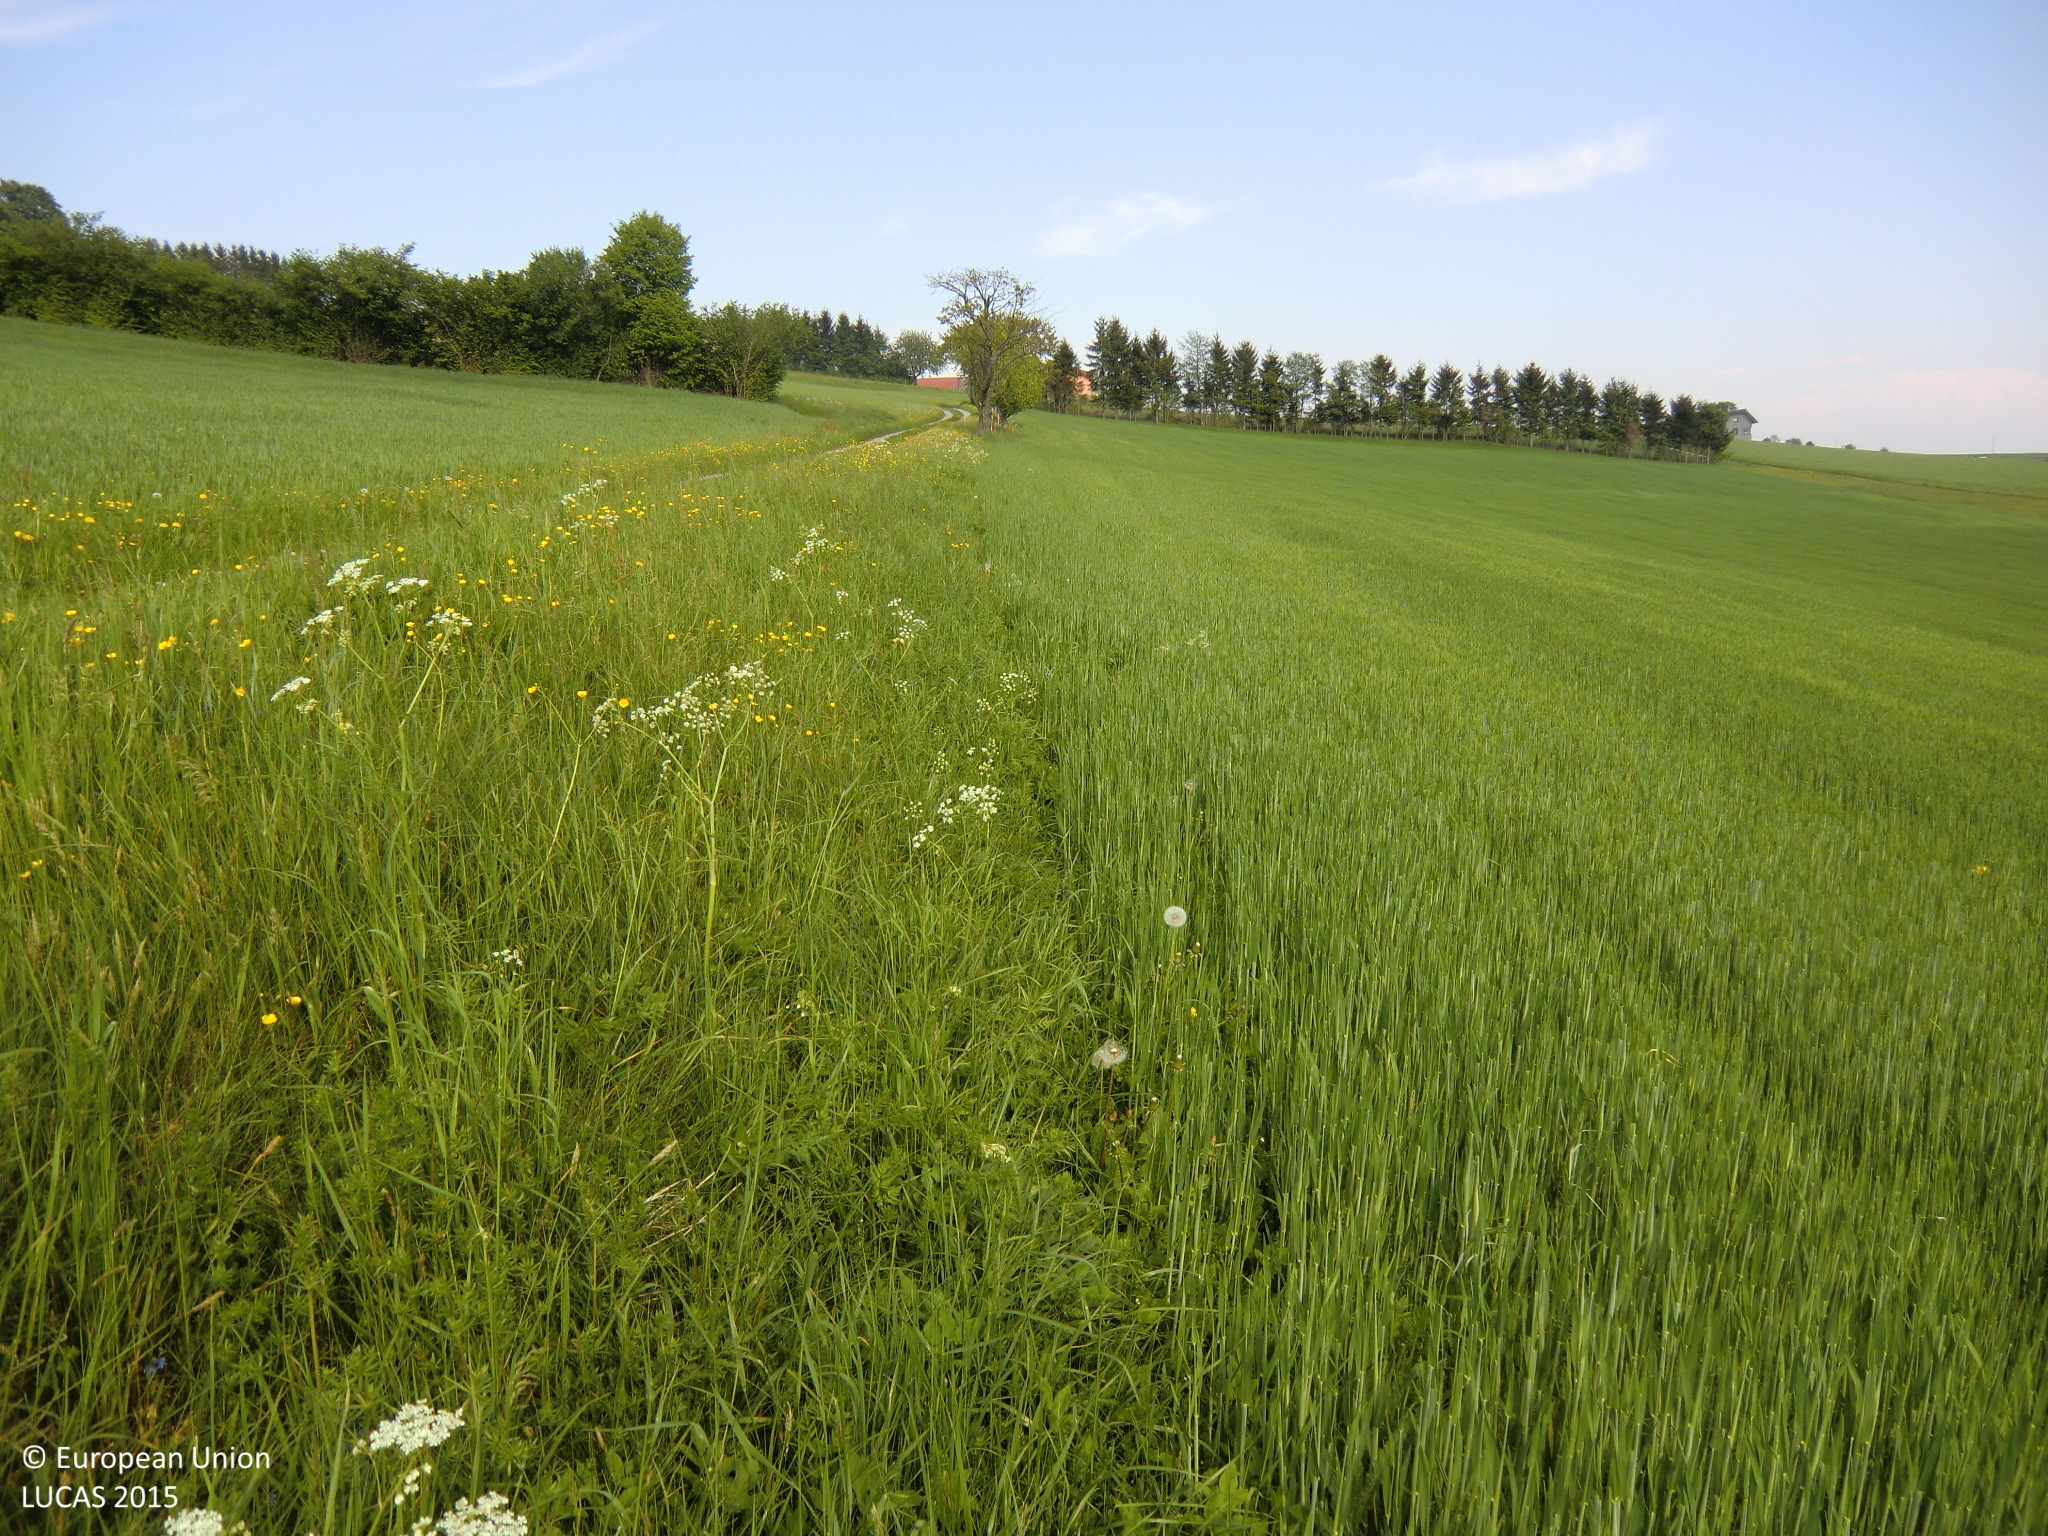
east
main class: Cropland
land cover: Barley
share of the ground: > 75 %
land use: Agriculture (excluding fallow land and kitchen gardens)
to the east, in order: Barley; Grass margins; Tracks; Grassland without tree/shrub cover; Paved roads, cycling and walking lanes; Grassland without tree/shrub cover
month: May
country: AT
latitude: 48.3916
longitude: 14.3084
